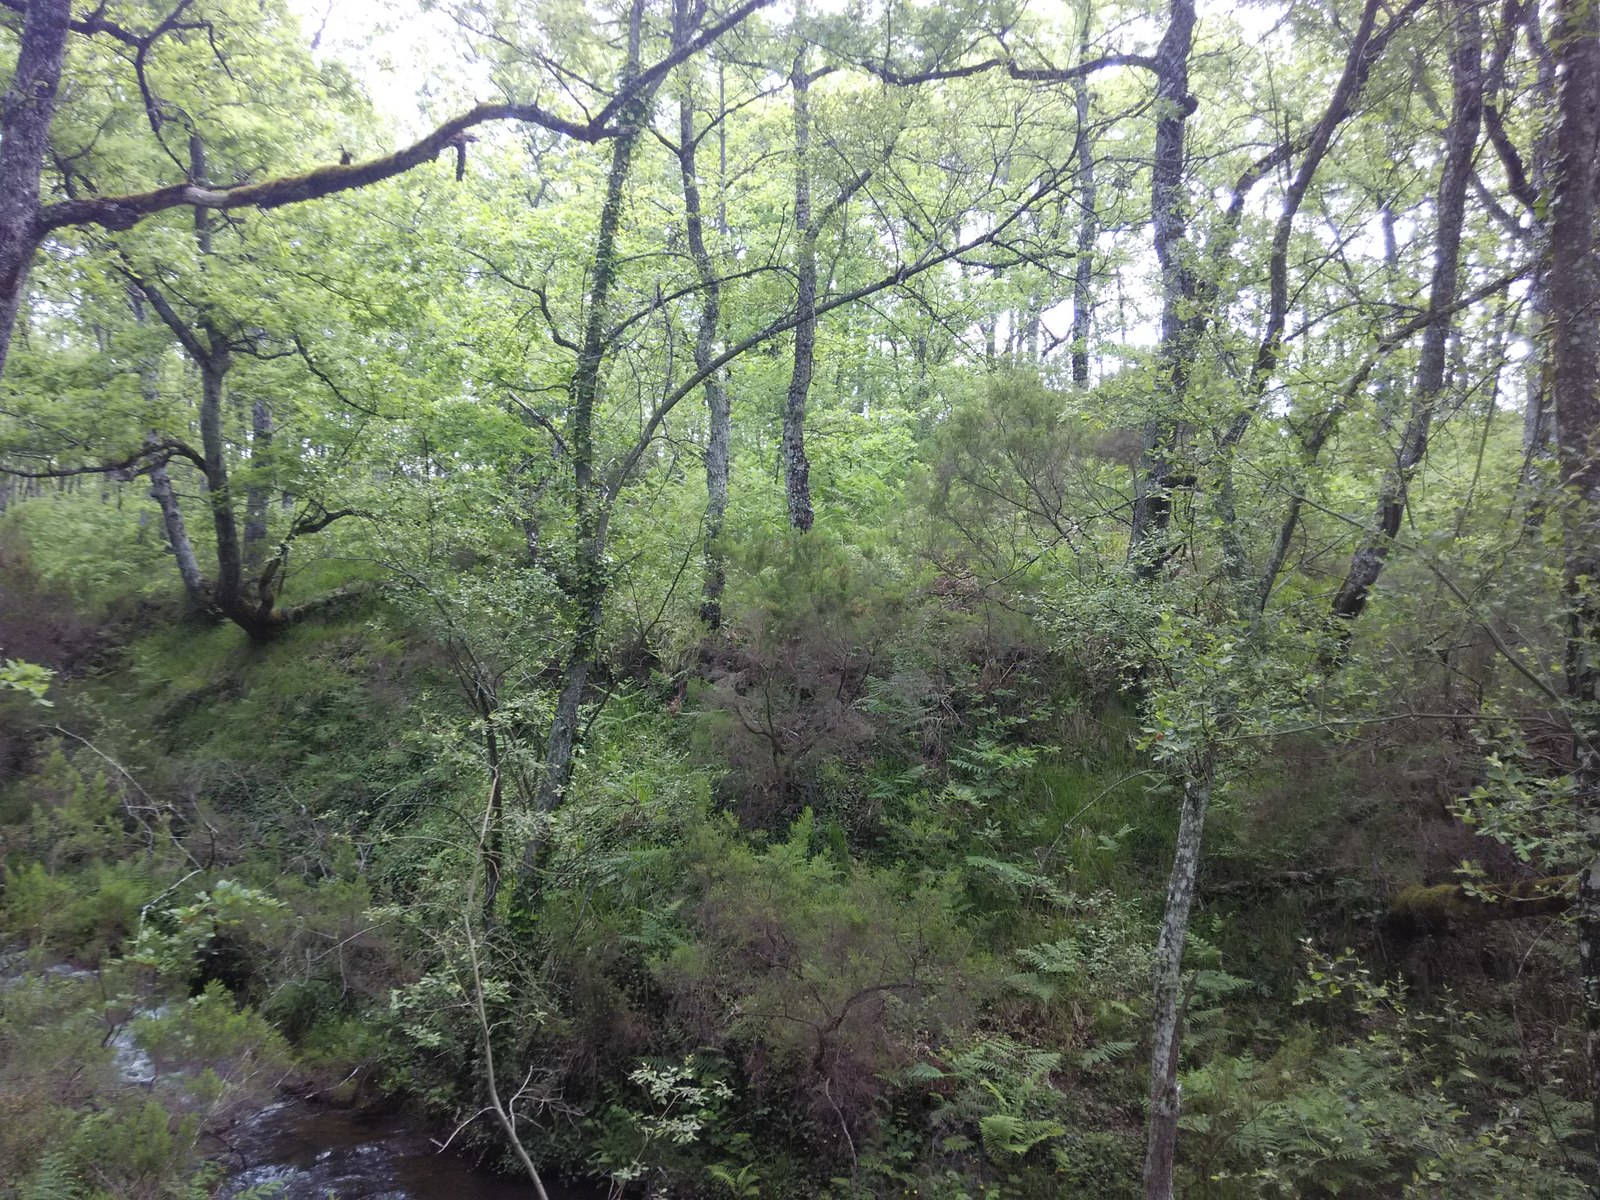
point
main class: Woodland
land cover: Broadleaved woodland
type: acidophilous oak and oak-birch forest
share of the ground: > 75 %
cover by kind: broadleaved forest trees 80 %, shrubs 10 %, herbaceous plants 10 %
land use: Forestry
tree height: > 5 m
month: June
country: ES
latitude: 42.9363
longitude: -2.4877
